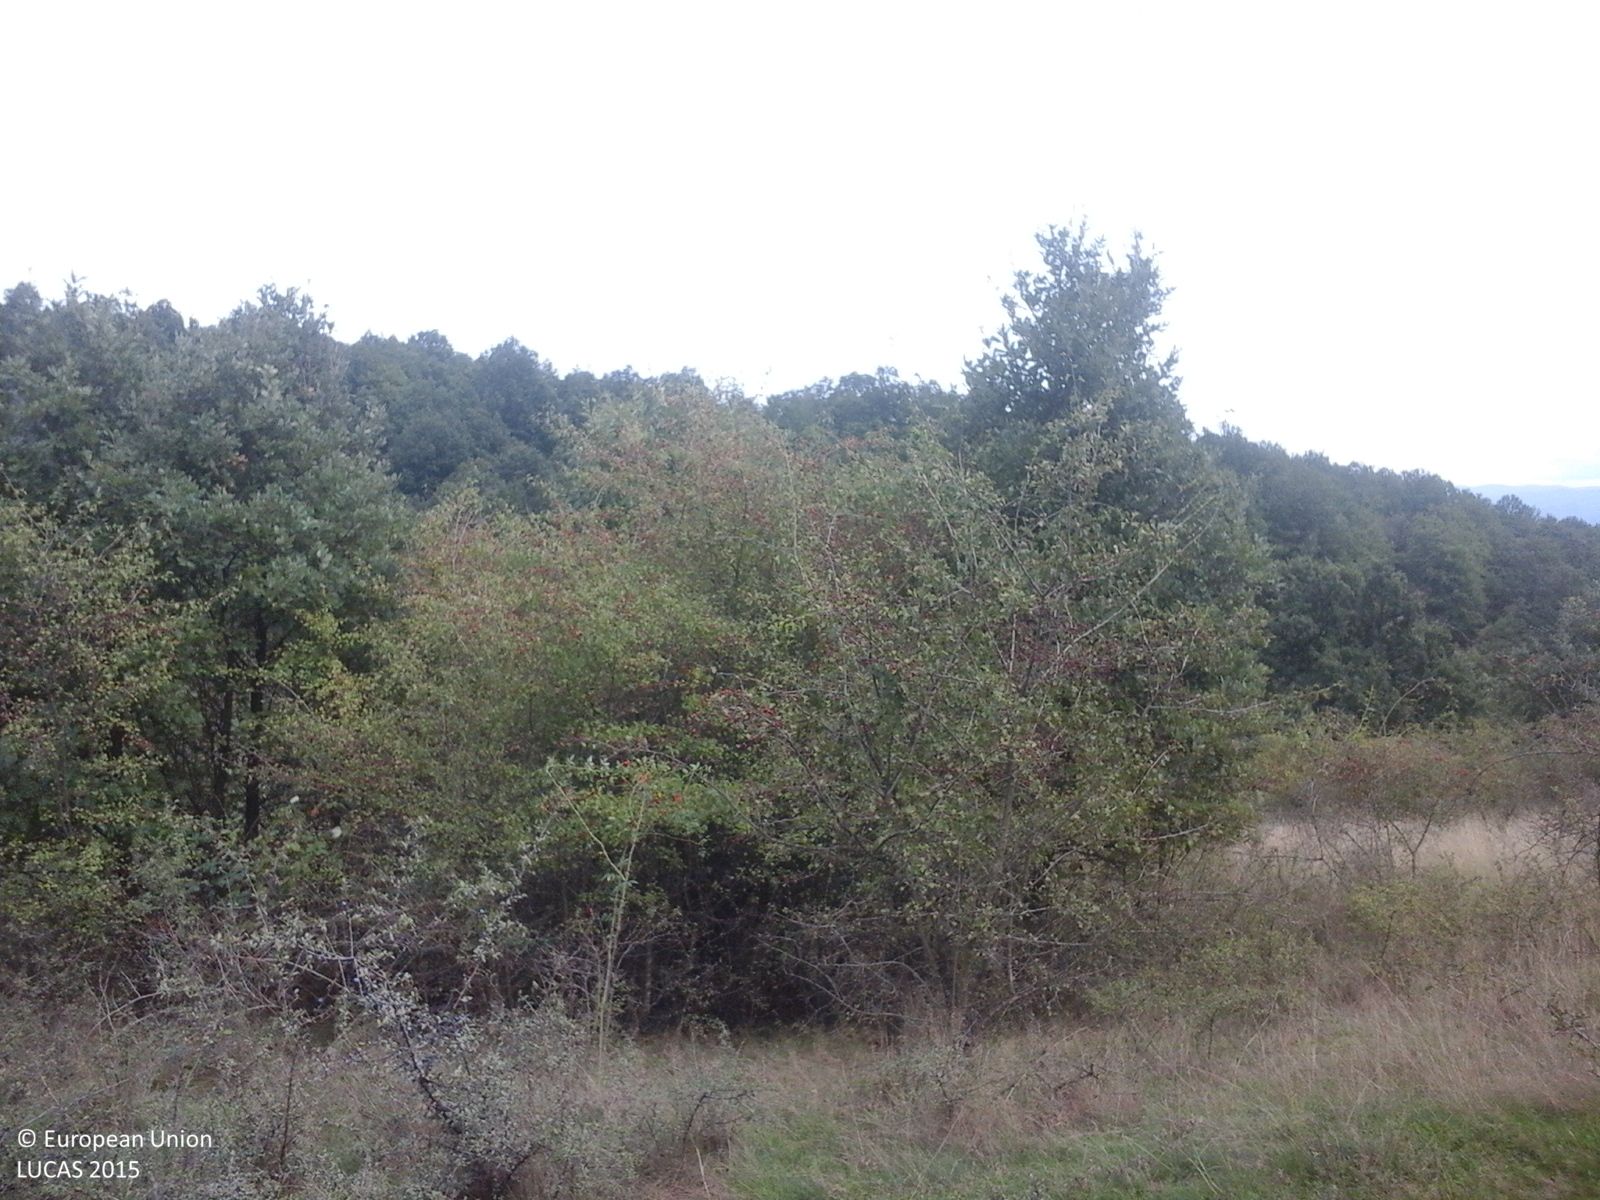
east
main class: Grassland
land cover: Grassland with sparse tree/shrub cover
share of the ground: > 75 %
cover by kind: herbaceous plants 85 %, shrubs 10 %, broadleaved forest trees 5 %
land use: Agriculture (excluding fallow land and kitchen gardens)
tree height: < 5 m
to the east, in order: Grassland with sparse tree/shrub cover; Shrubland with sparse tree cover; Grassland with sparse tree/shrub cover; Broadleaved woodland
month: September
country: RO
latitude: 45.8835
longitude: 23.1363
